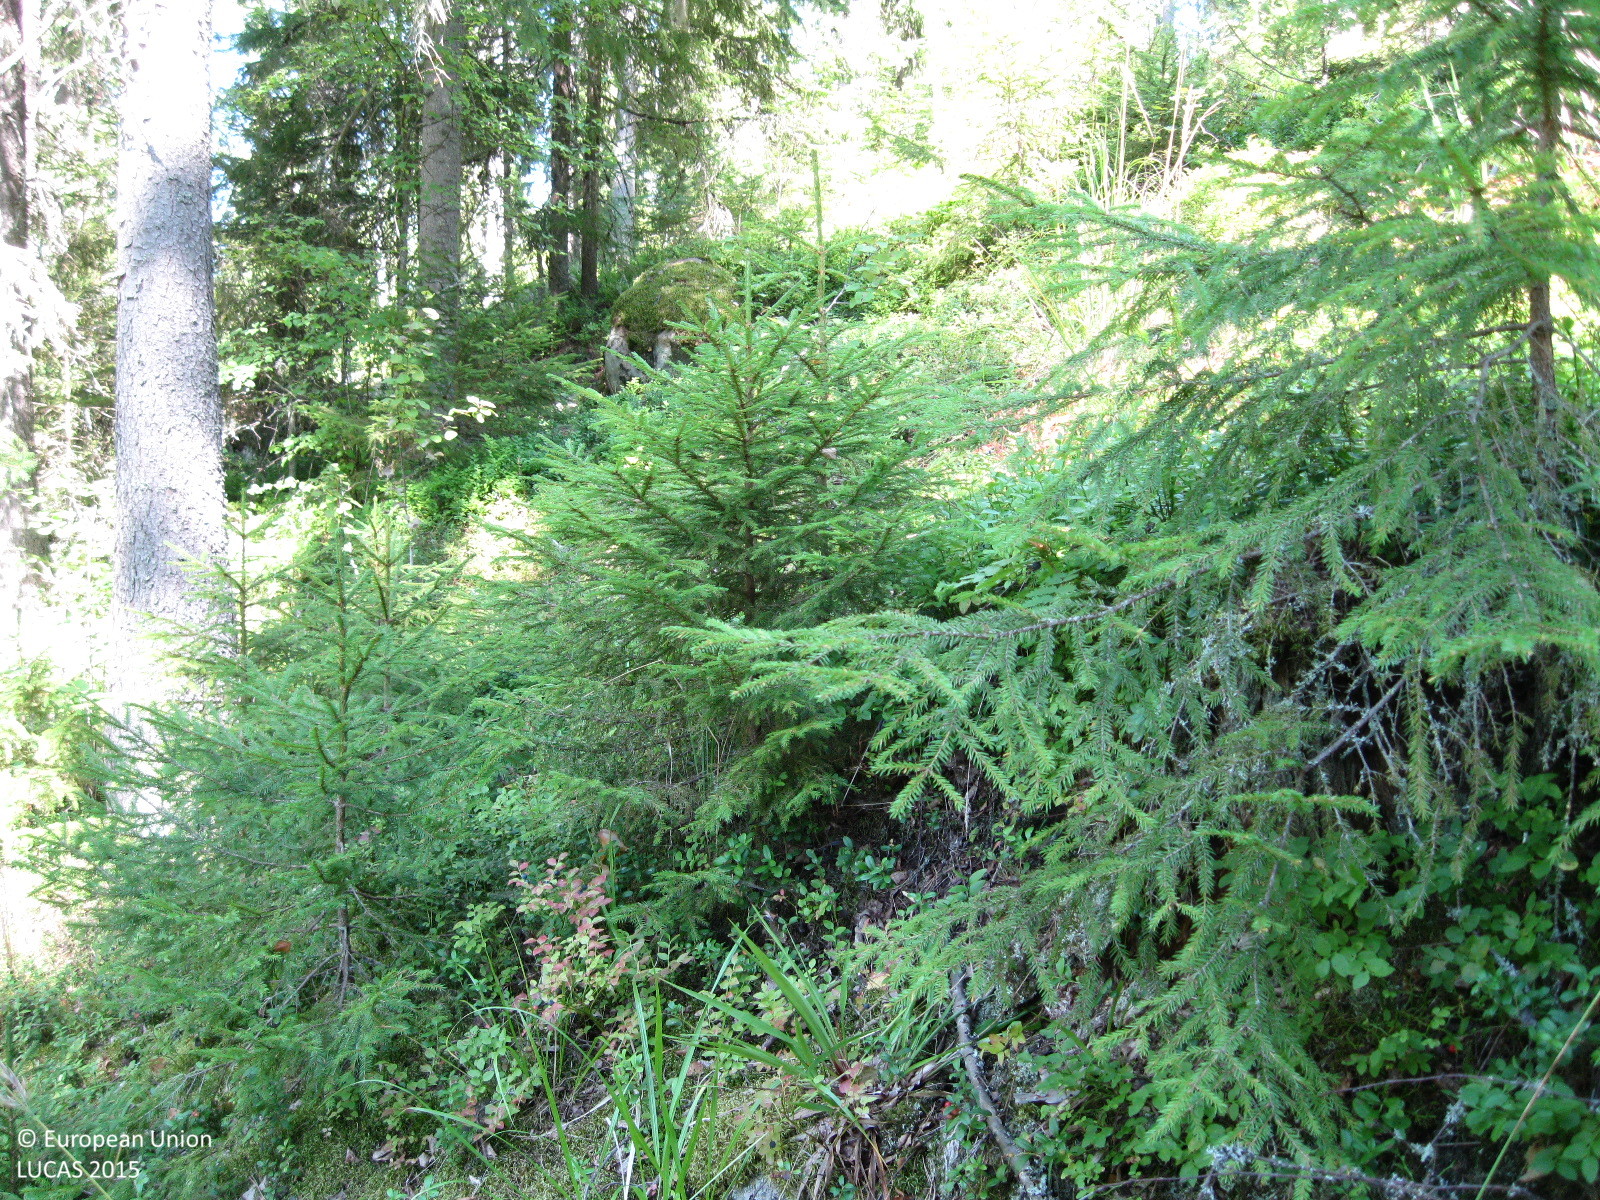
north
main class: Woodland
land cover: Other mixed woodland
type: boreal forest
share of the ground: 25 - 50 %
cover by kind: shrubs 50 %, coniferous forest trees 30 %, broadleaved forest trees 10 %, herbaceous plants 10 %
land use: Forestry
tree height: > 5 m
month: August
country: FI
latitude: 61.3347
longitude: 25.0432
